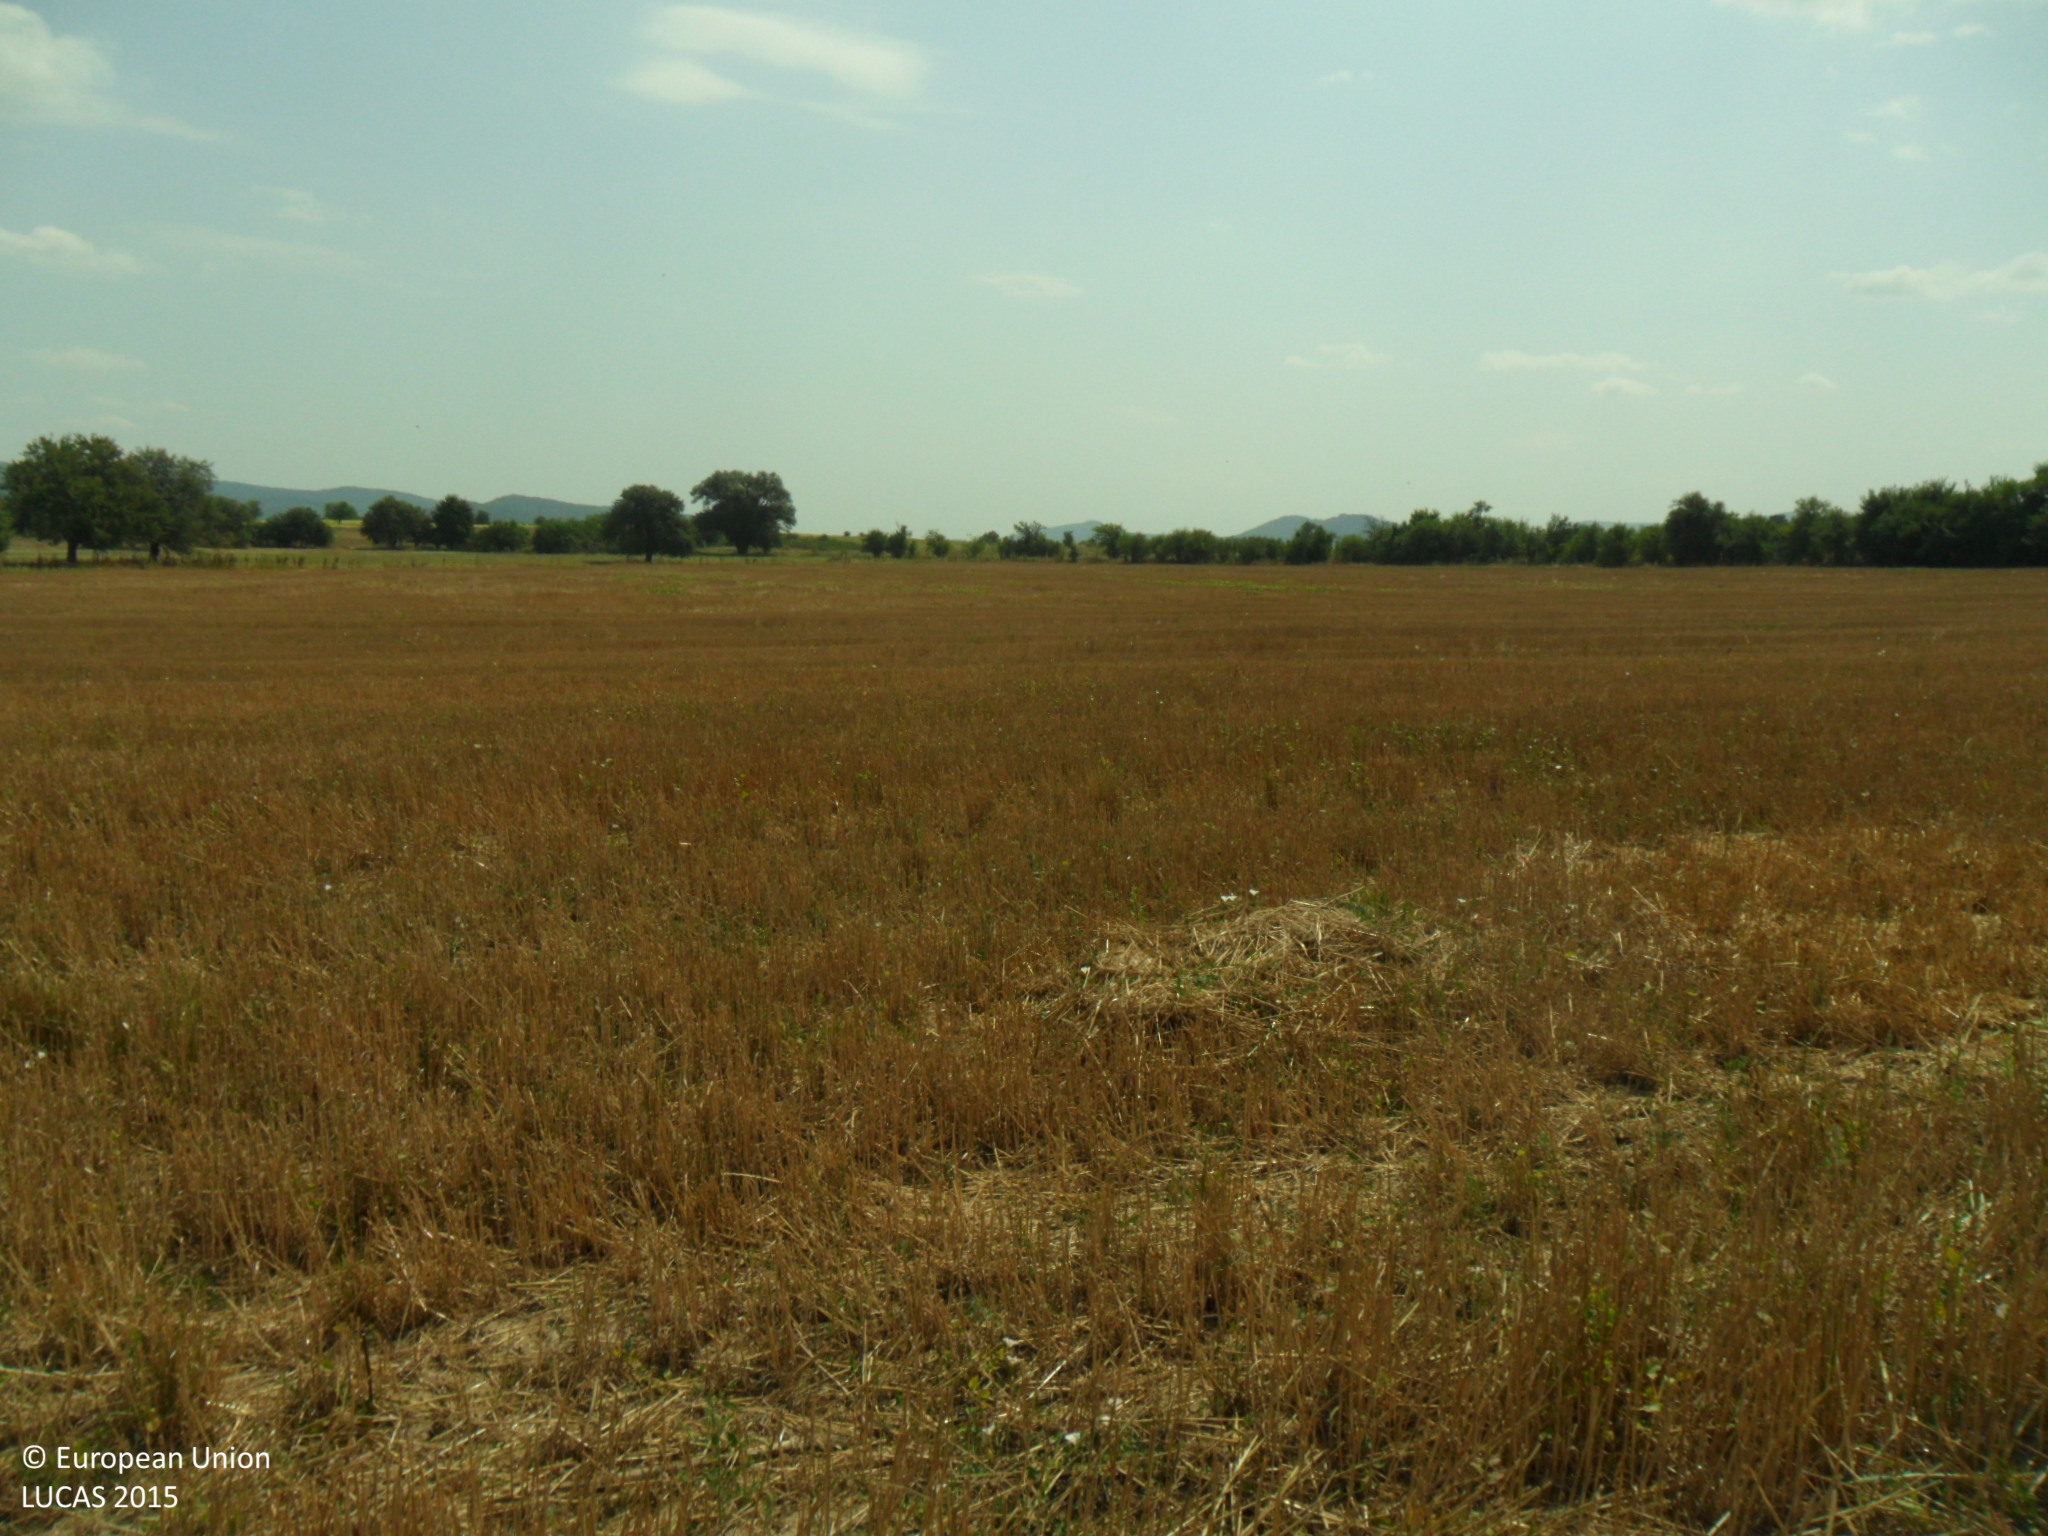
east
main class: Cropland
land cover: Common wheat
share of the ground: > 75 %
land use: Agriculture (excluding fallow land and kitchen gardens)
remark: Harvested field
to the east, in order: Common wheat; Tracks; Grassland with sparse tree/shrub cover
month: August
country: BG
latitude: 43.0092
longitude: 26.7786
